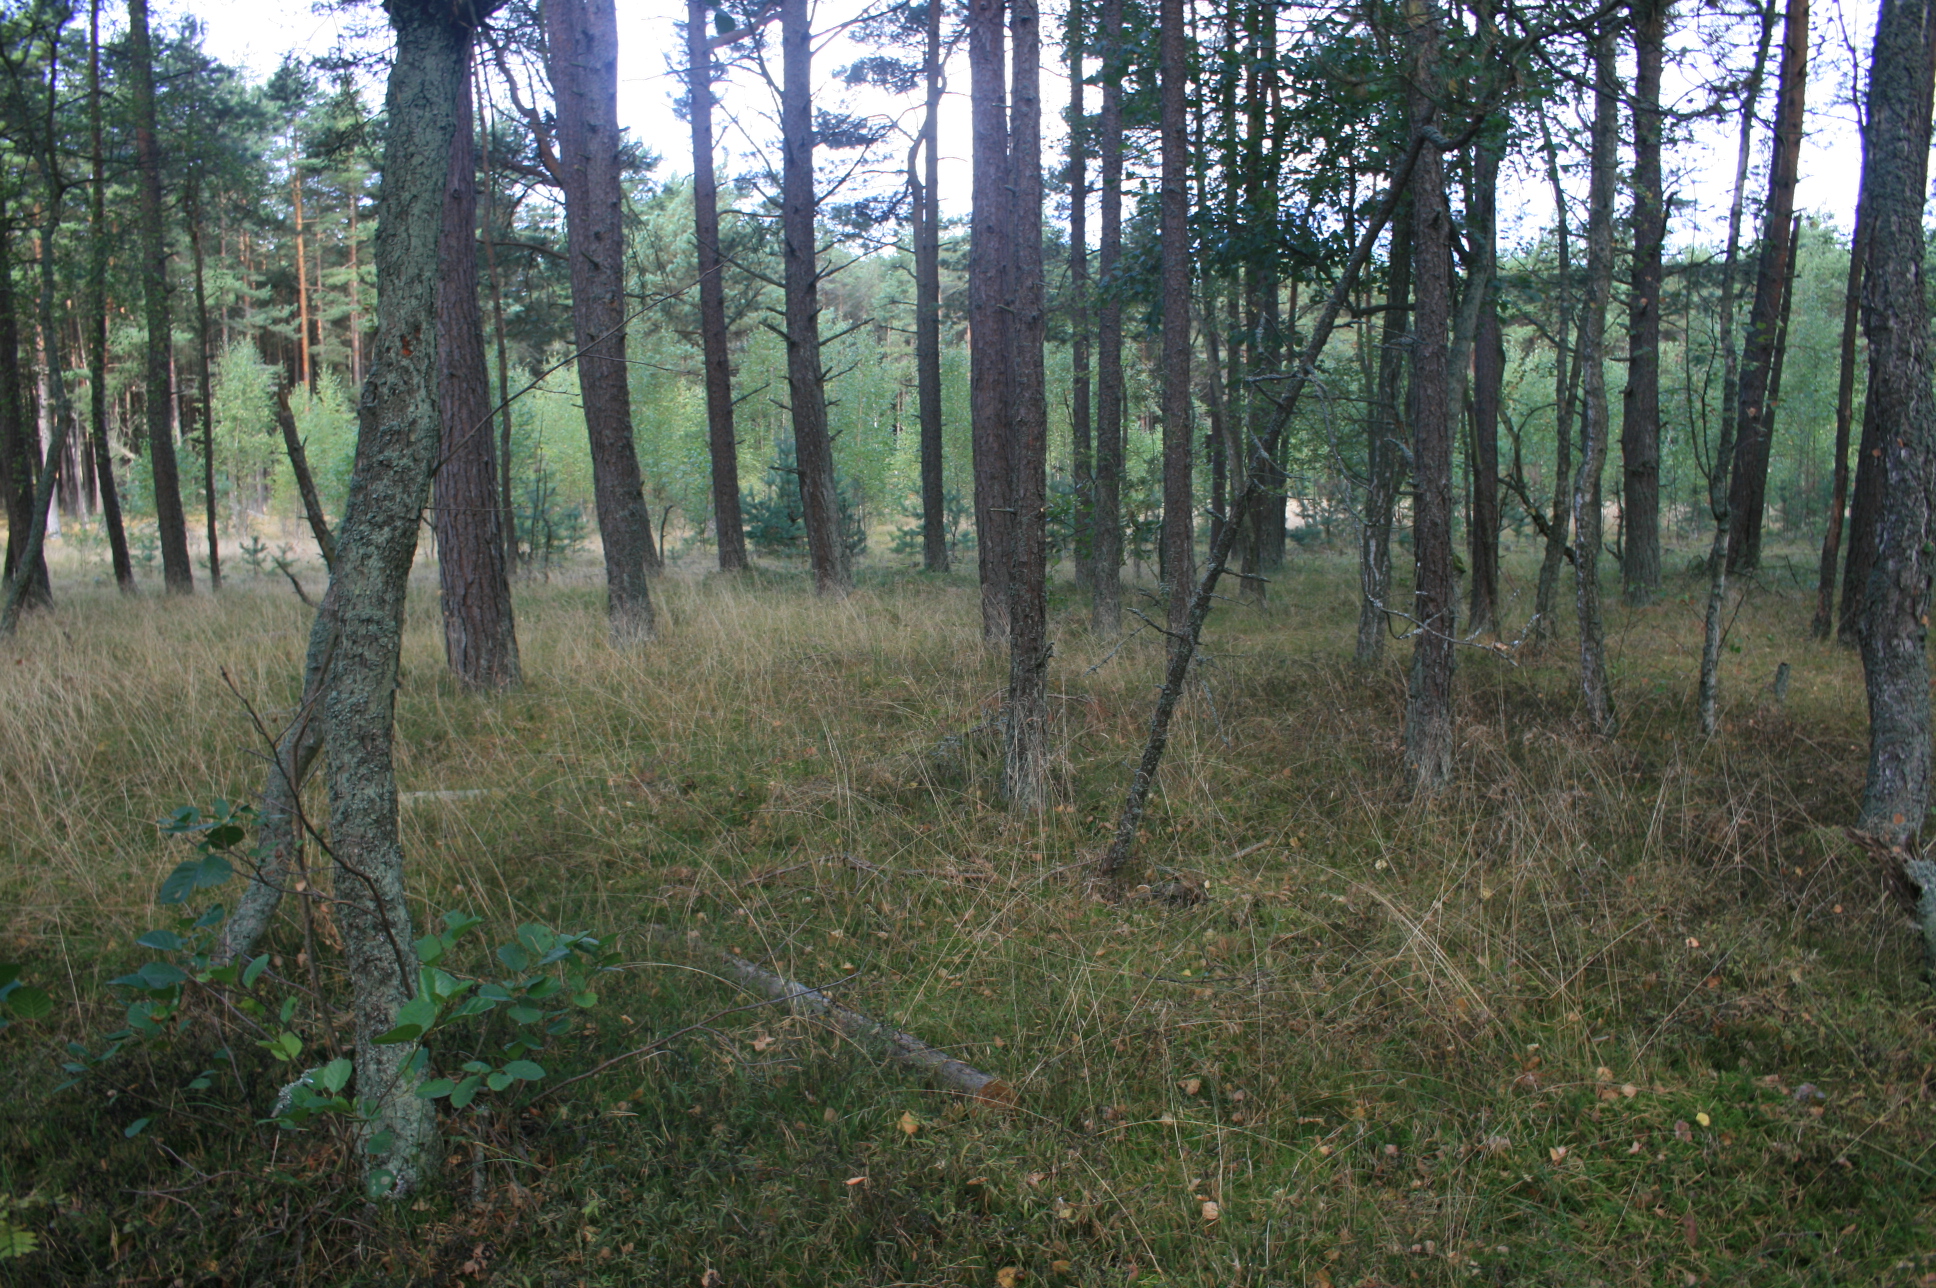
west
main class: Woodland
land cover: Pine dominated coniferous woodland
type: hemiboreal forest and nemoral coniferous forest and mixed broadleaved-coniferous forest
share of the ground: > 75 %
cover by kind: coniferous forest trees 80 %, herbaceous plants 10 %, lichens and mosses 10 %
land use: Forestry
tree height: > 5 m
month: September
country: LT
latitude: 55.3978
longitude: 21.0775
